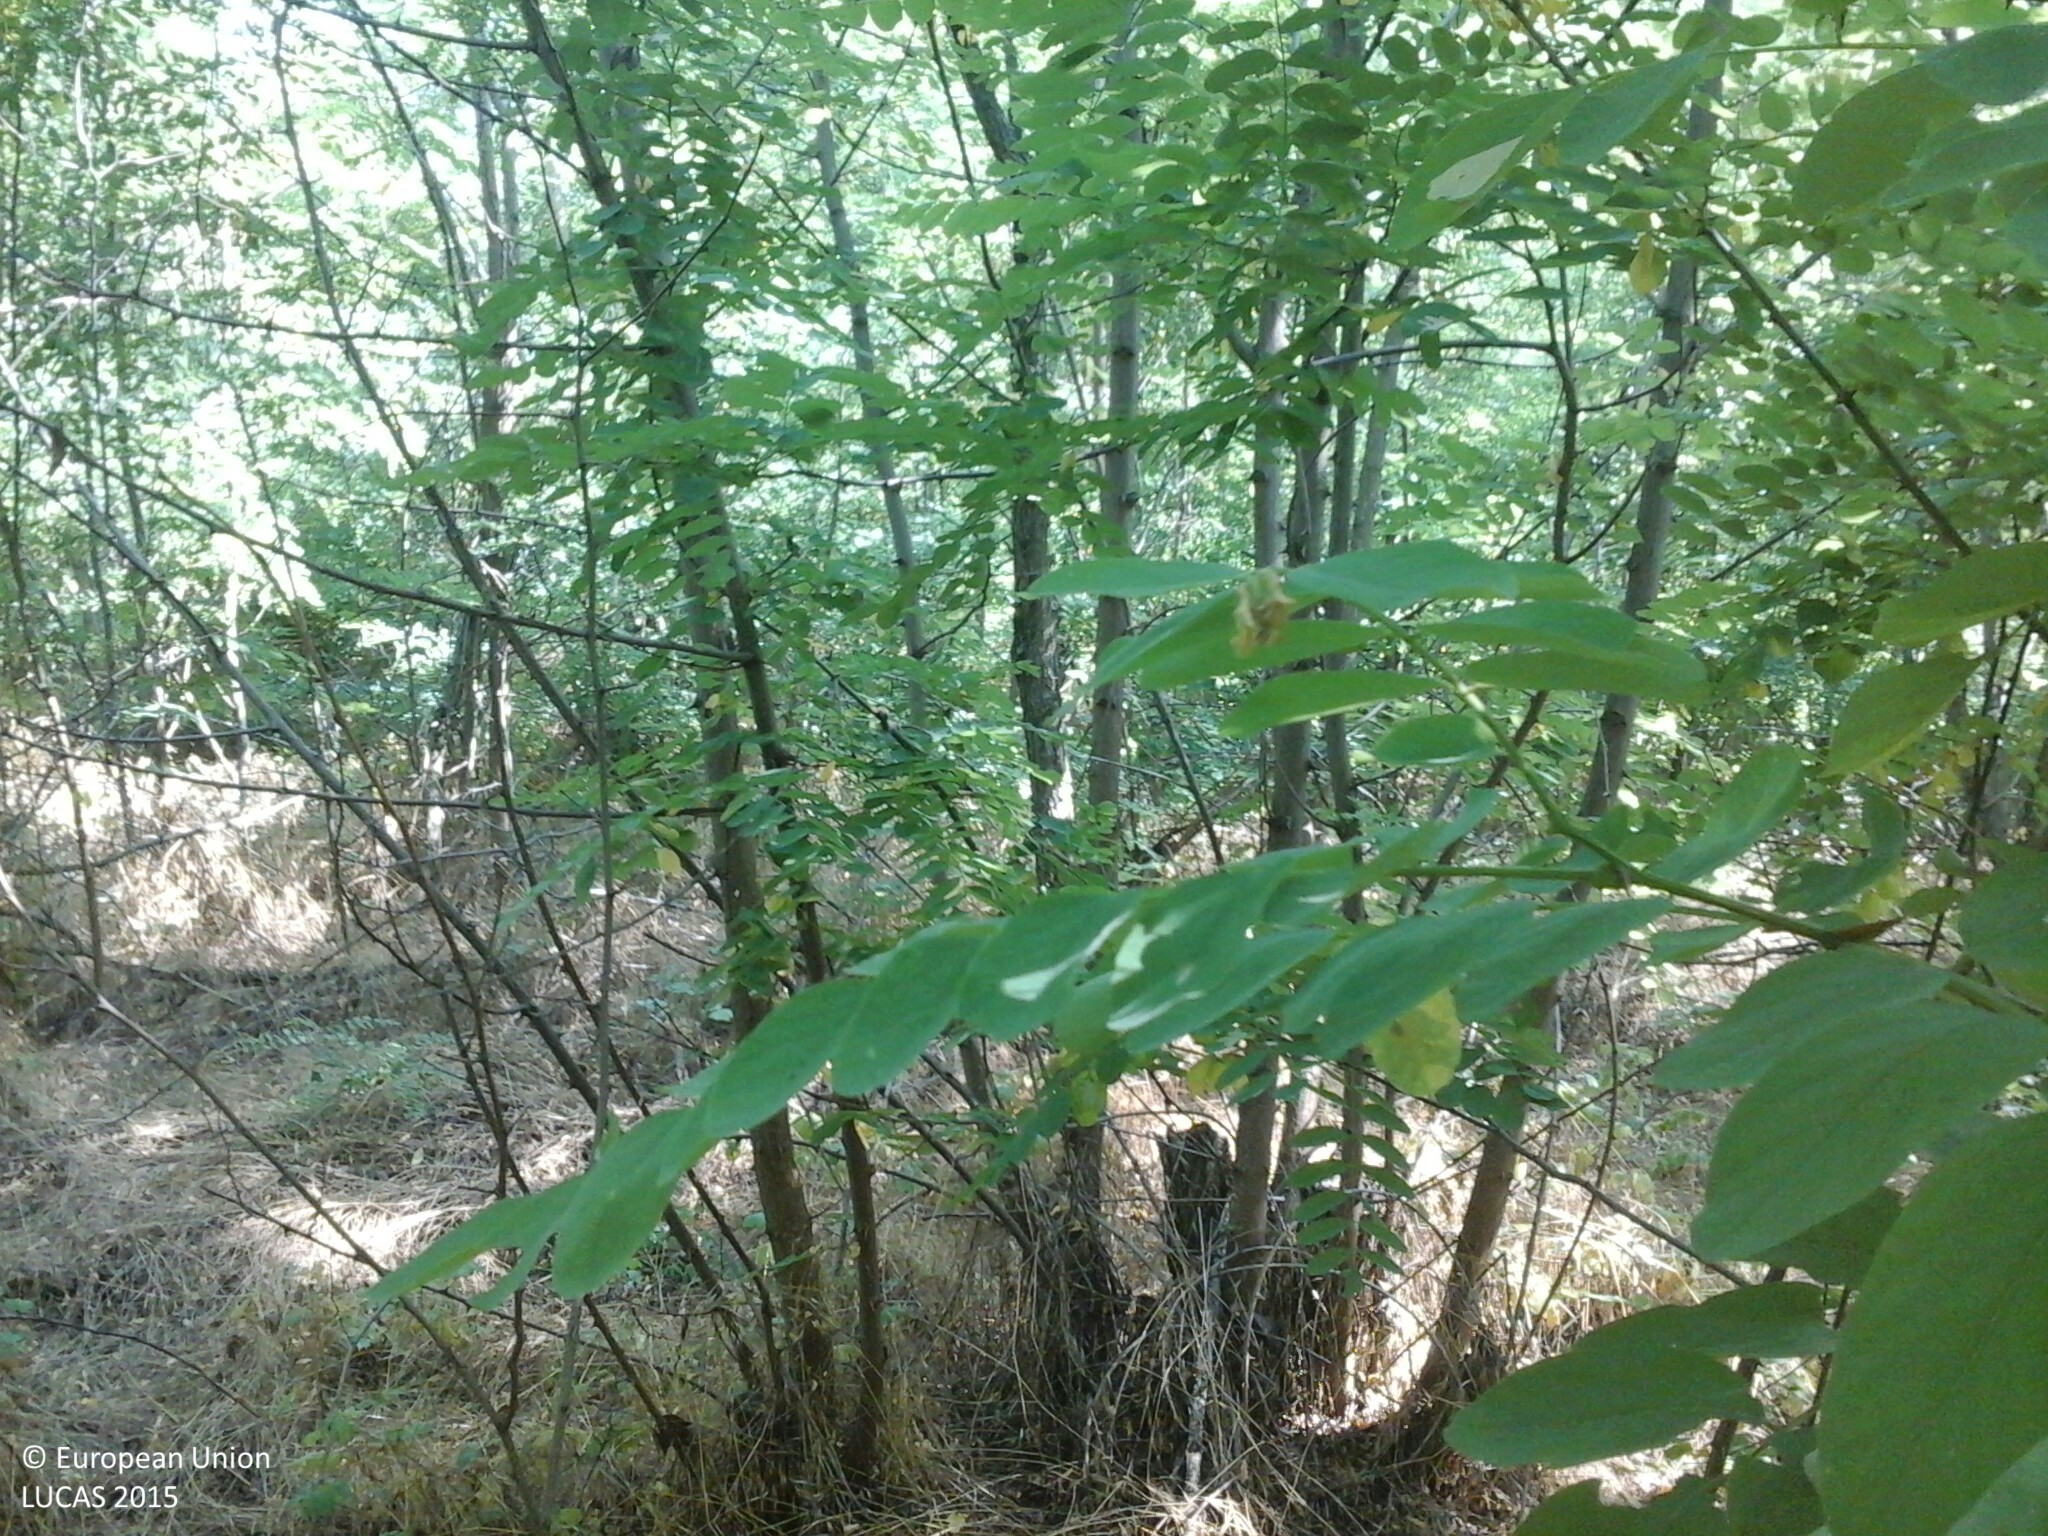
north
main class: Woodland
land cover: Broadleaved woodland
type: exotic forest
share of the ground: > 75 %
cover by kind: broadleaved forest trees 100 %
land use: Forestry
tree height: > 5 m
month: July
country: HU
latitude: 48.2713
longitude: 22.1955
